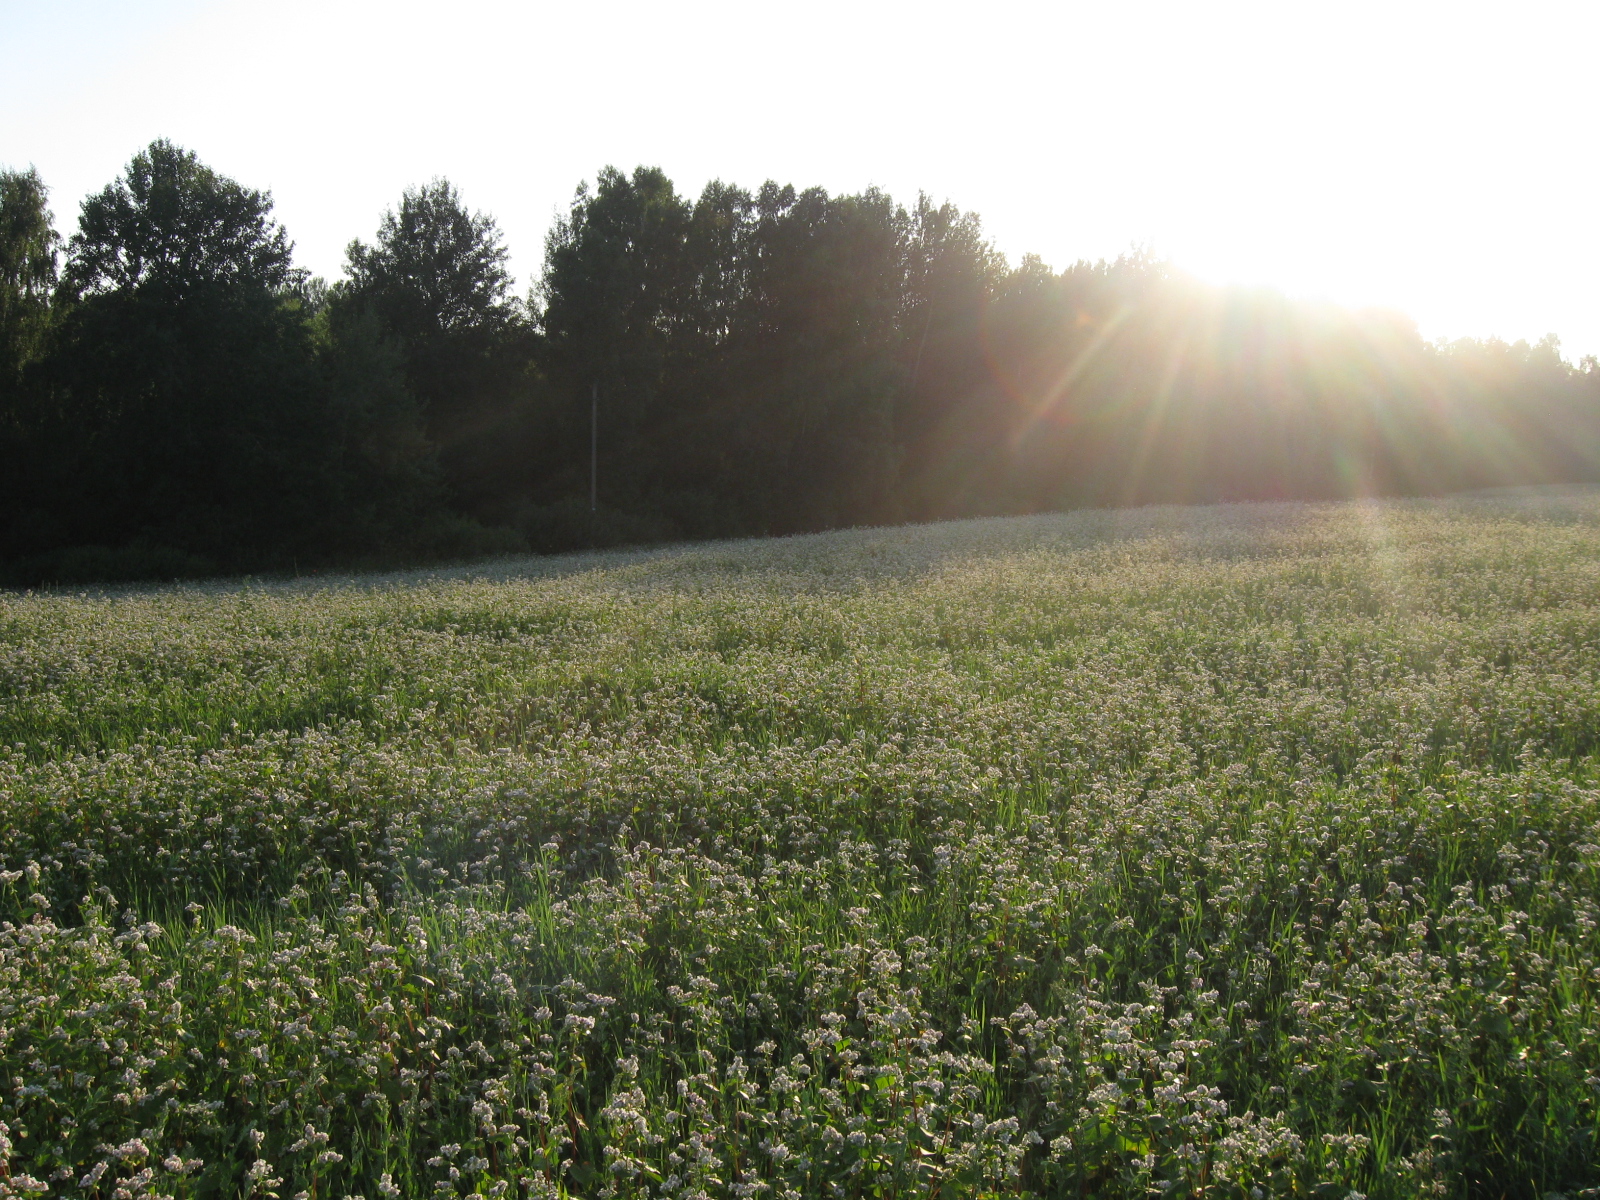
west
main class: Cropland
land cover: Other cereals
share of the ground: > 75 %
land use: Agriculture (excluding fallow land and kitchen gardens)
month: July
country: LT
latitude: 54.0746
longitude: 23.7352
